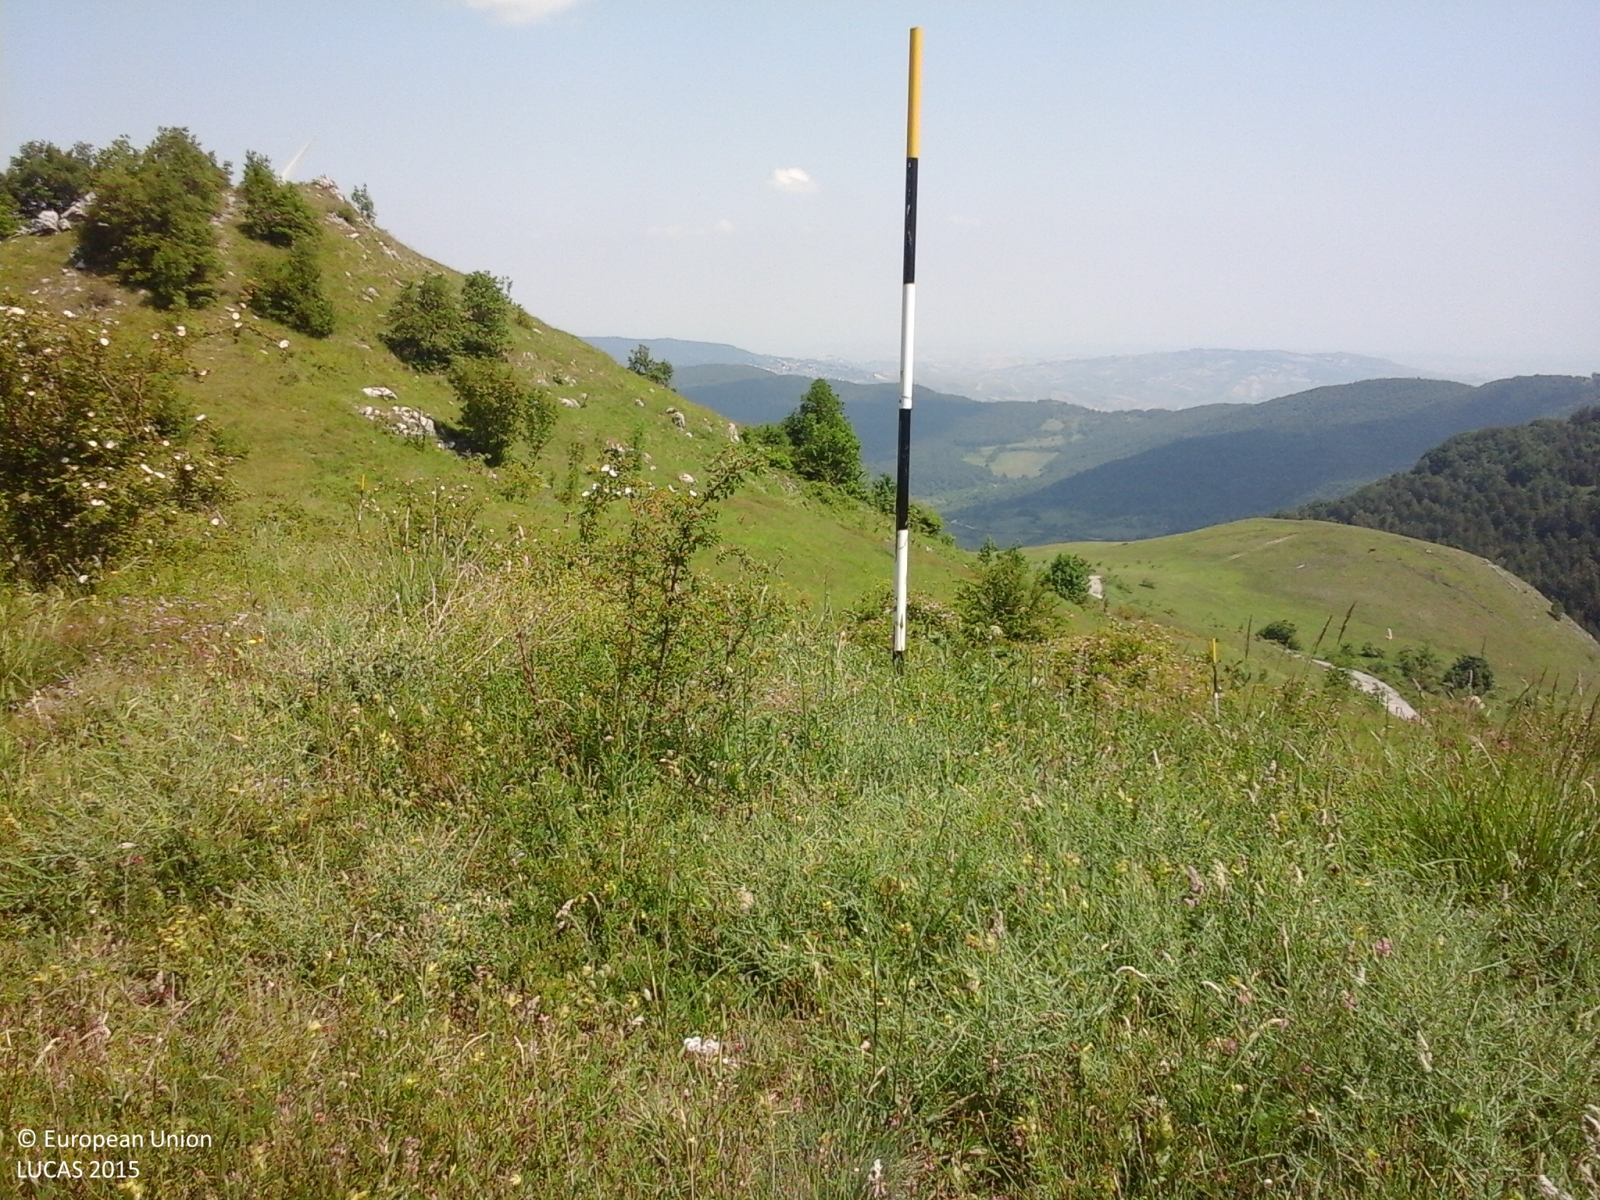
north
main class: Grassland
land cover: Grassland without tree/shrub cover
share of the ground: > 75 %
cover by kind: herbaceous plants 100 %
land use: Energy production
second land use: Agriculture (excluding fallow land and kitchen gardens)
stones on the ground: 10 - 25 %
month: June
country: IT
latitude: 41.9439
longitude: 14.3884
